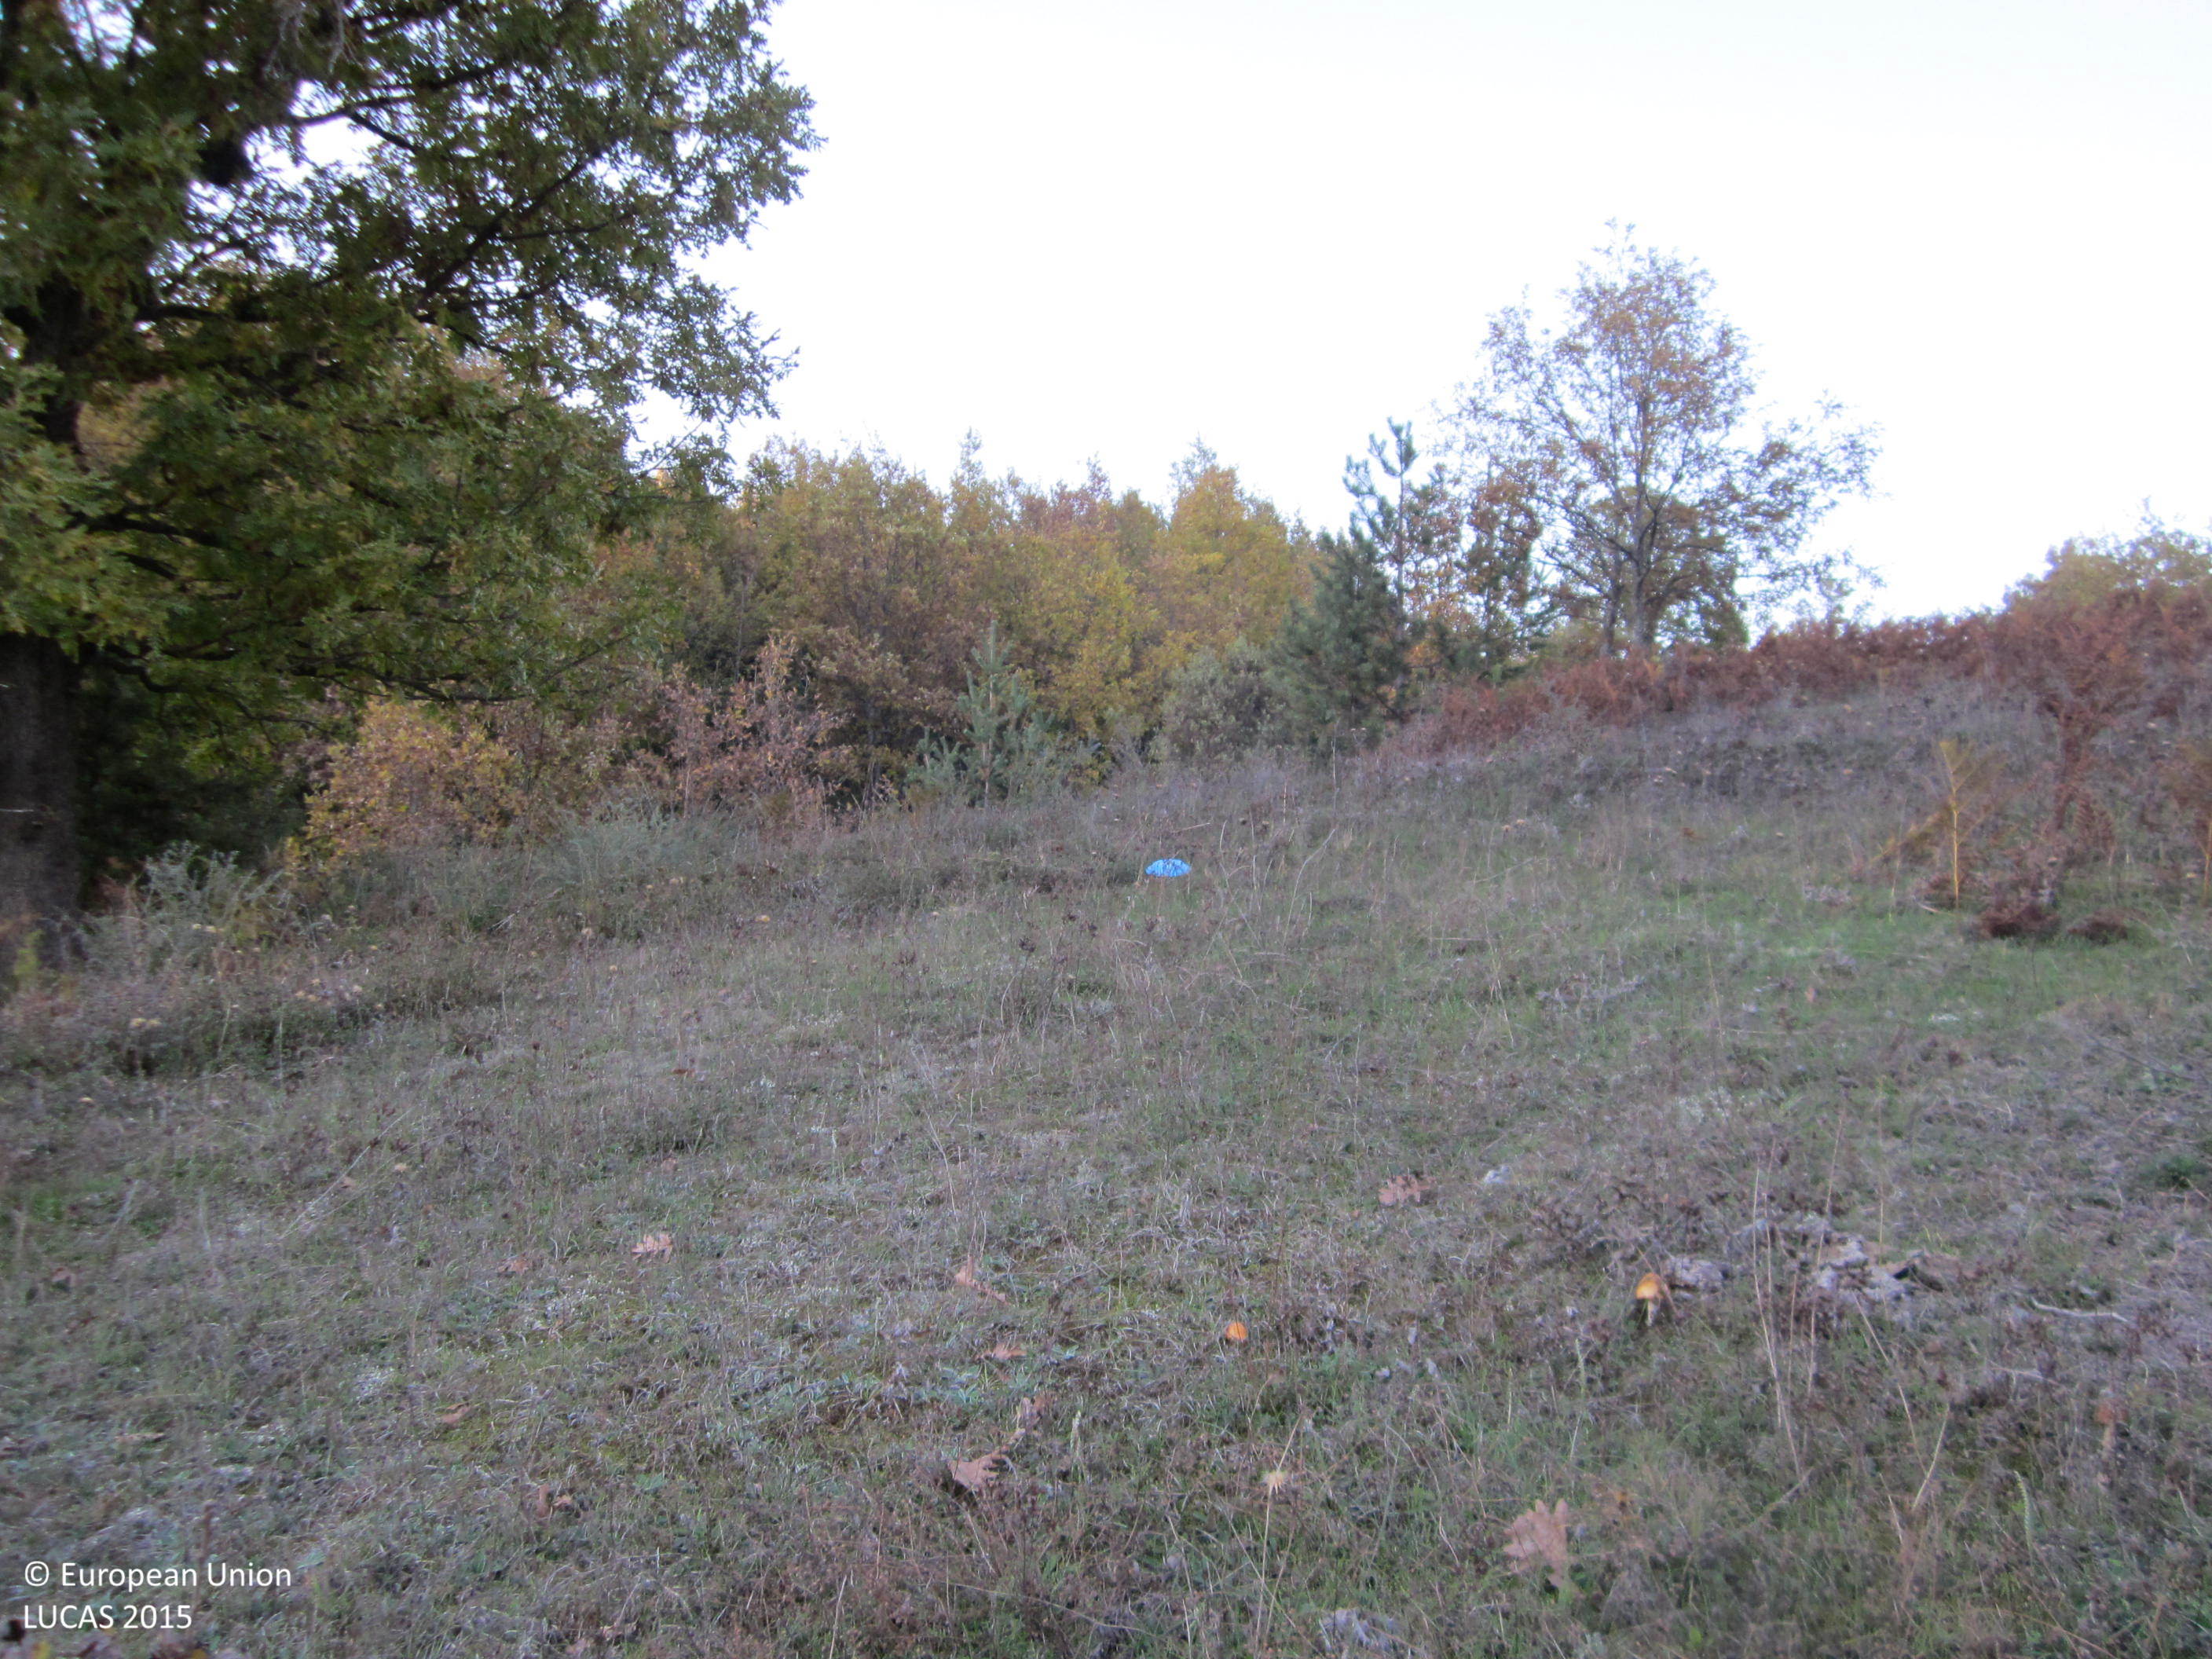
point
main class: Grassland
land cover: Grassland with sparse tree/shrub cover
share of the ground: > 75 %
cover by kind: herbaceous plants 85 %, shrubs 10 %, broadleaved forest trees 5 %
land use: Agriculture (excluding fallow land and kitchen gardens)
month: November
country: BG
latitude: 41.3782
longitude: 25.7364
